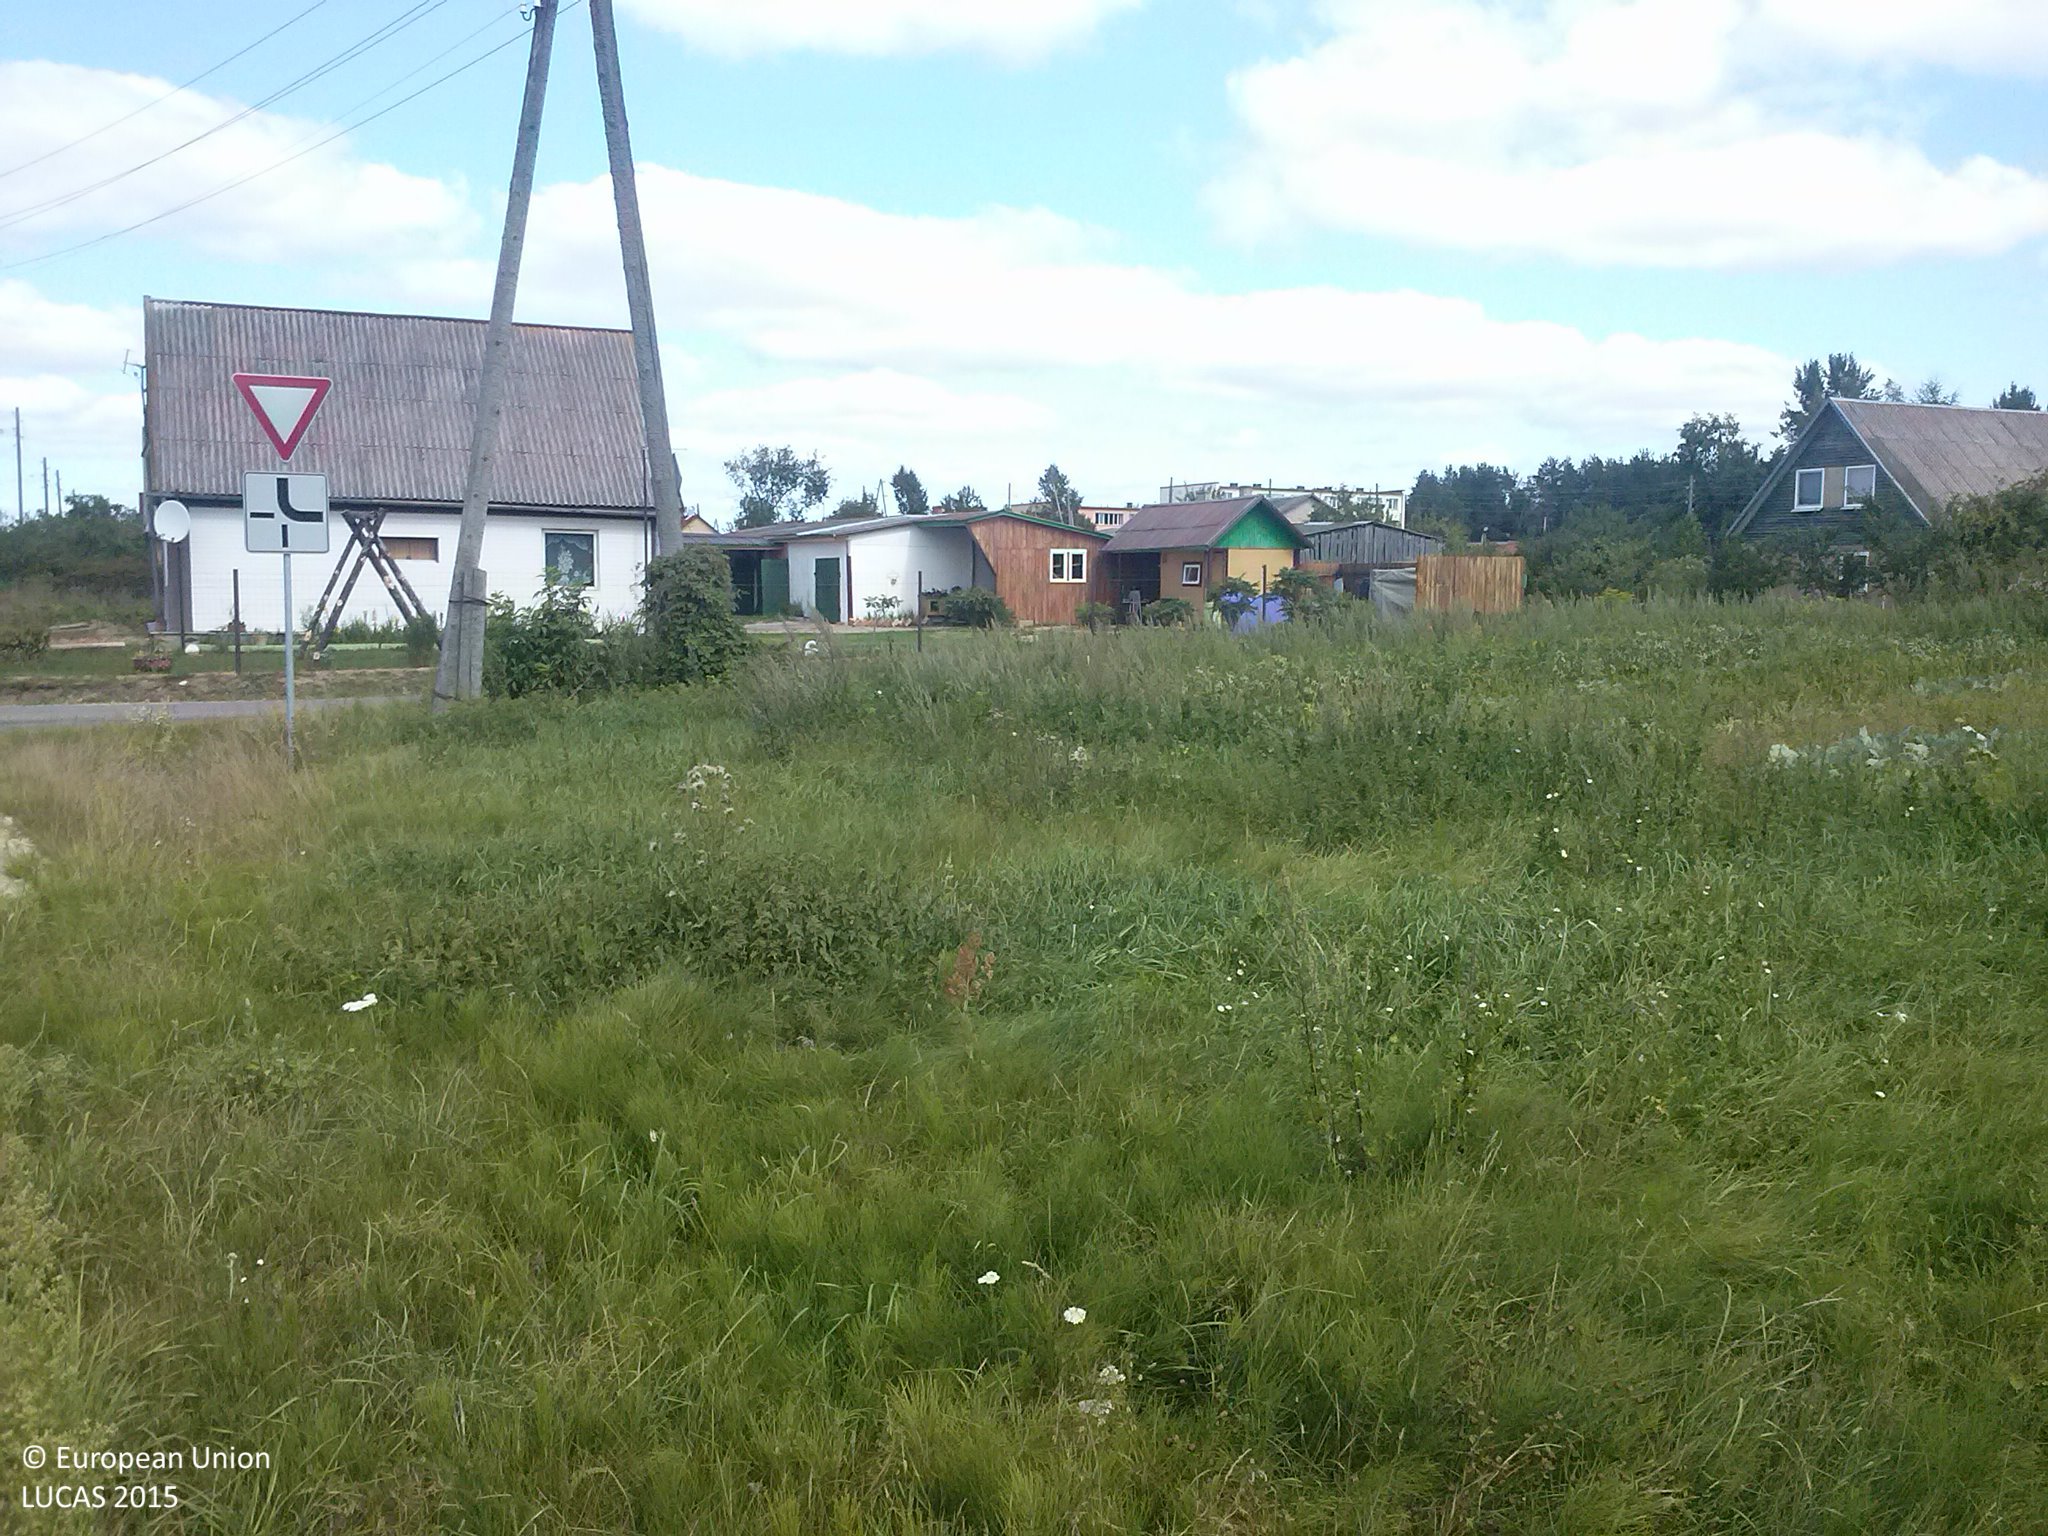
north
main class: Cropland
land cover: Apple fruit
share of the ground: 50 - 75 %
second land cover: Grassland without tree/shrub cover
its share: > 75 %
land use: Kitchen garden
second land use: Residential
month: August
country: LV
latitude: 56.1469
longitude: 26.7188
